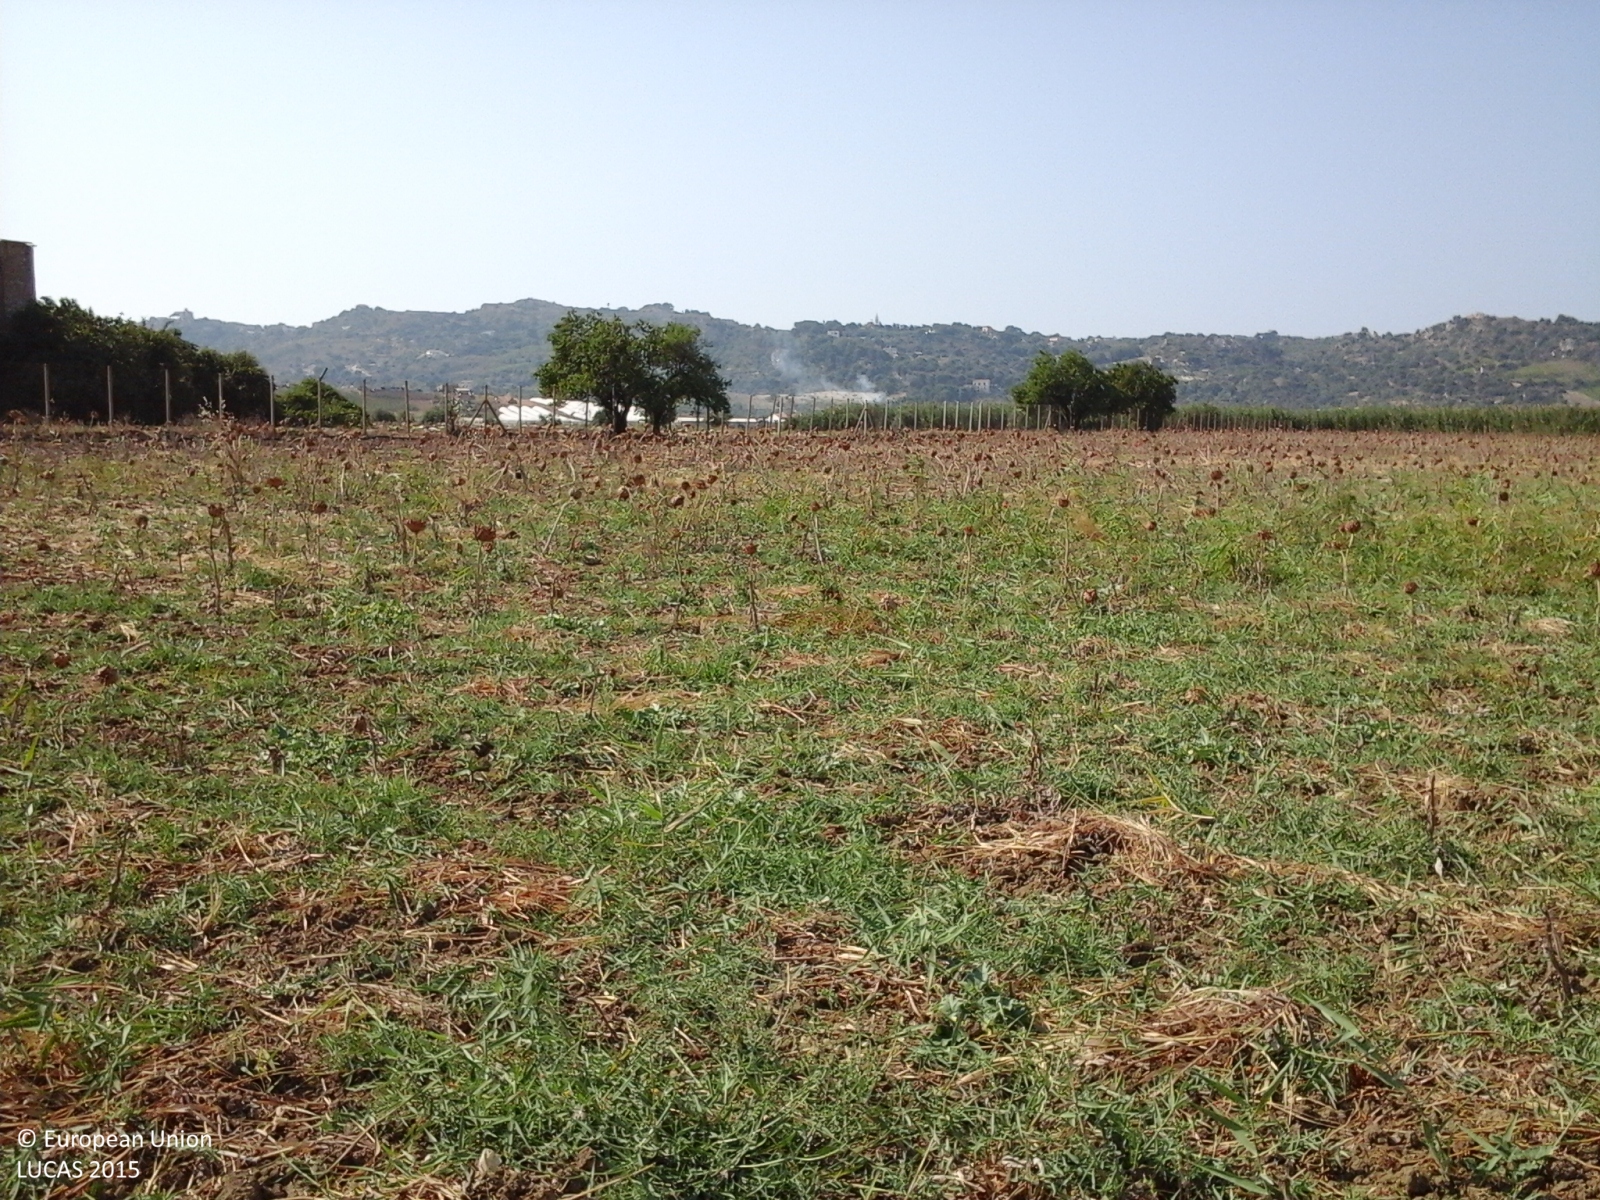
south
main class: Cropland
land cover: Other fresh vegetables
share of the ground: > 75 %
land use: Agriculture (excluding fallow land and kitchen gardens)
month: July
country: IT
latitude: 37.1223
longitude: 13.8971
